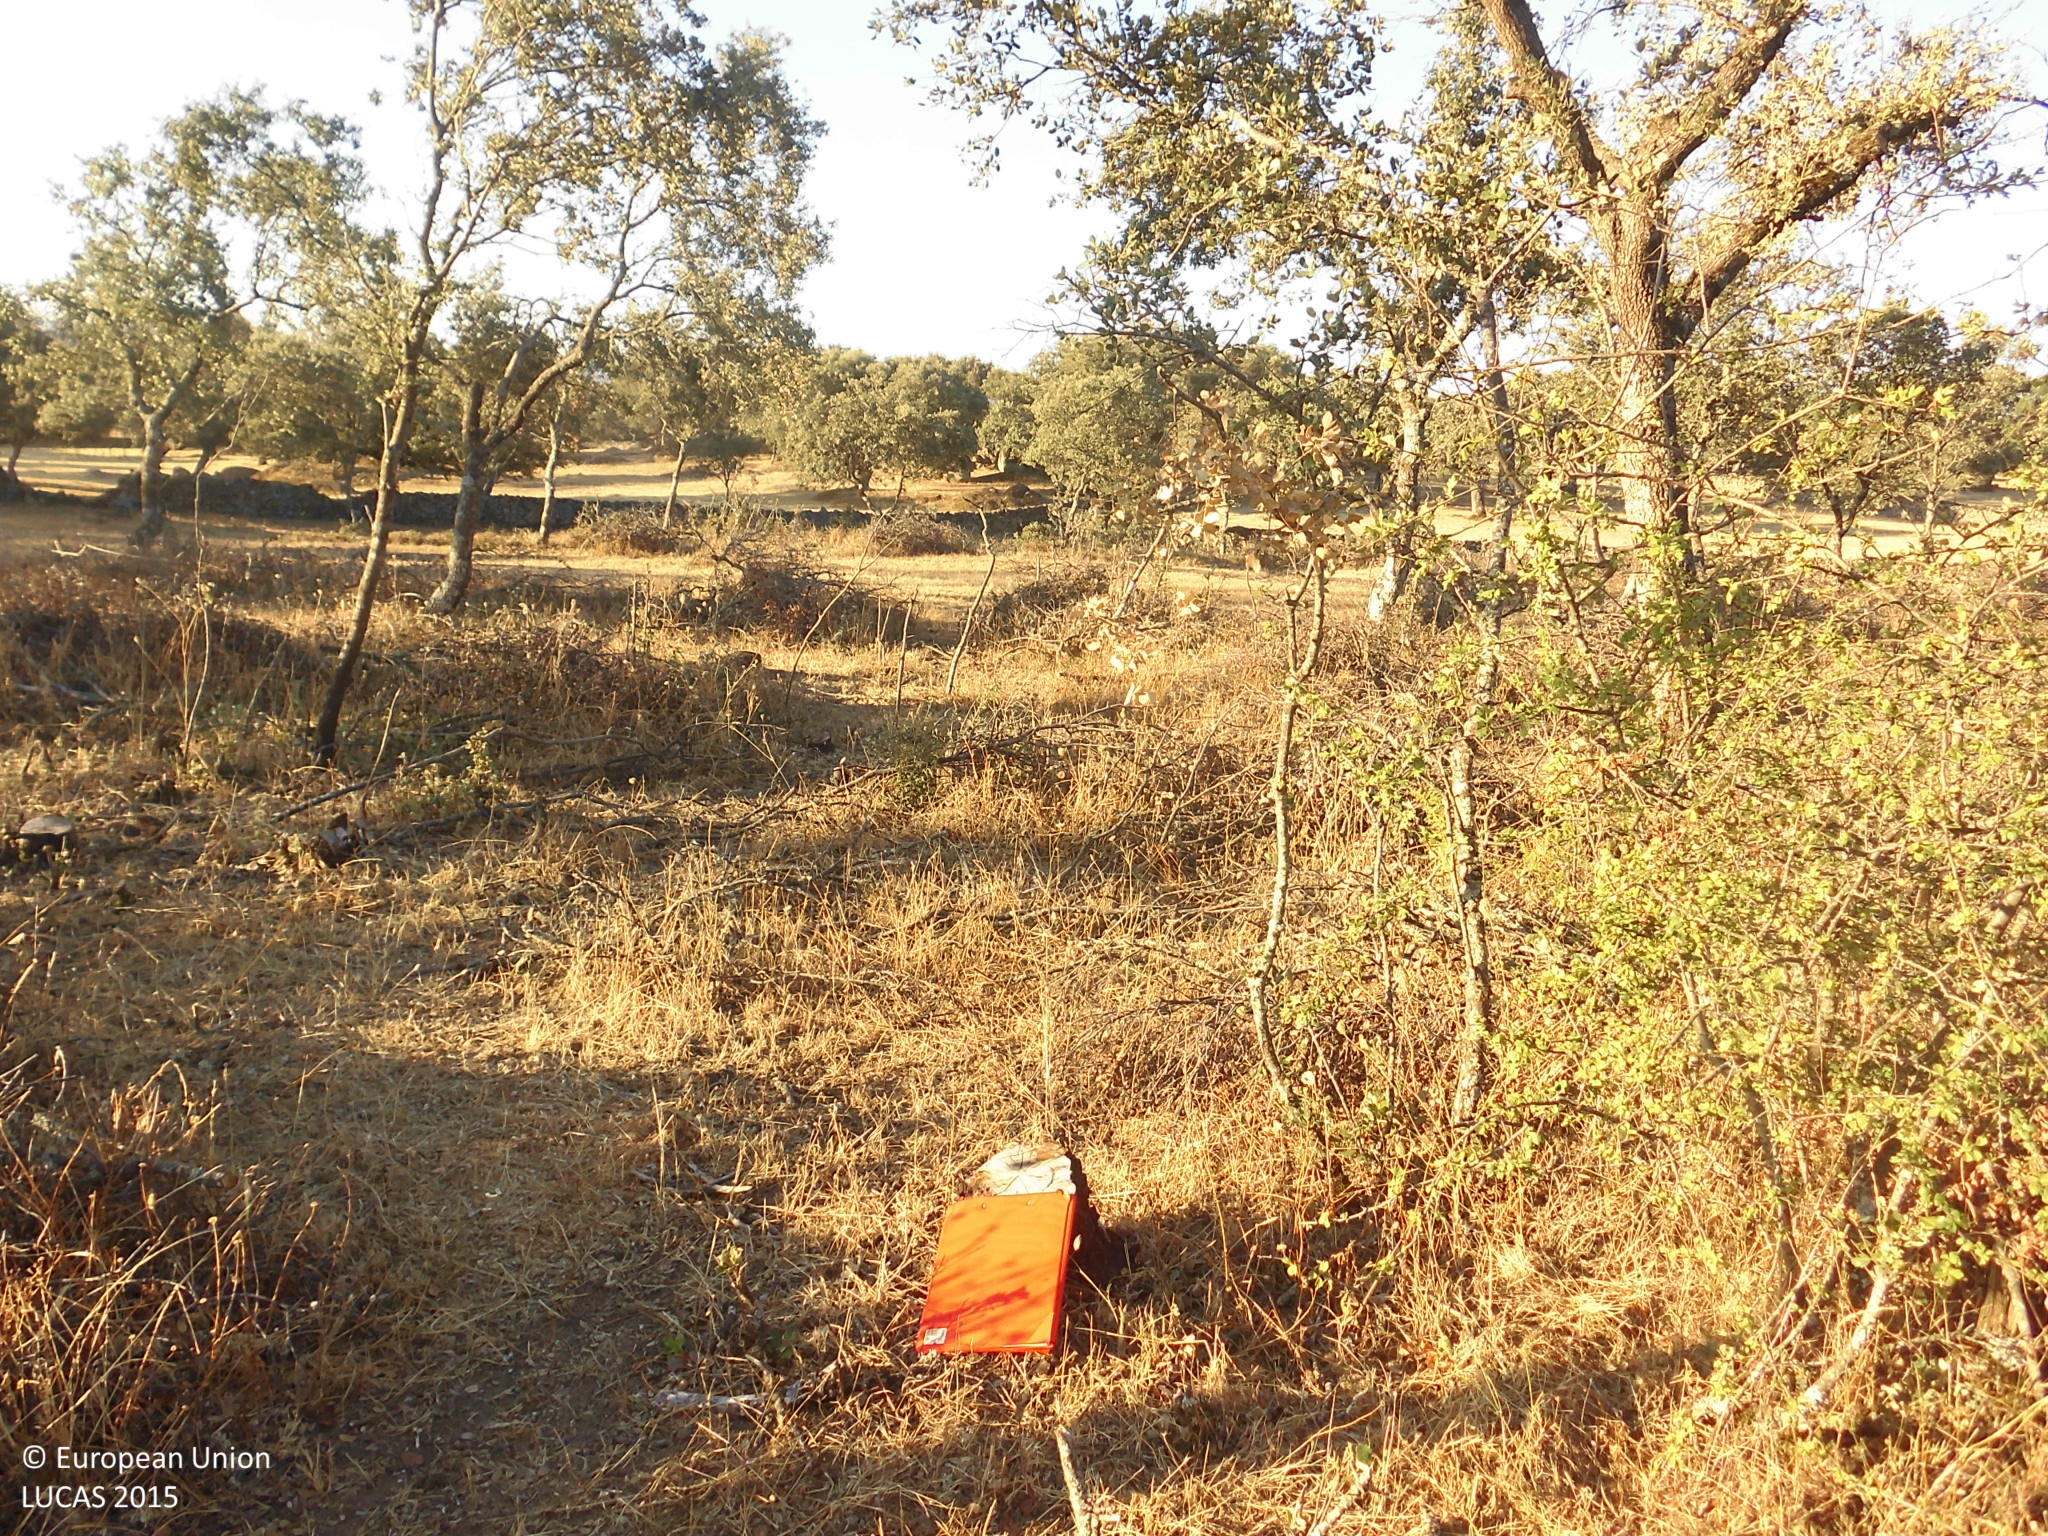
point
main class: Woodland
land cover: Broadleaved woodland
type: broadleaved evergreen forest
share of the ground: 25 - 50 %
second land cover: Grassland without tree/shrub cover
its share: > 75 %
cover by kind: herbaceous plants 65 %, broadleaved forest trees 35 %
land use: Forestry
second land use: Agriculture (excluding fallow land and kitchen gardens)
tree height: > 5 m
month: July
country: ES
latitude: 40.1102
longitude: -6.1829
